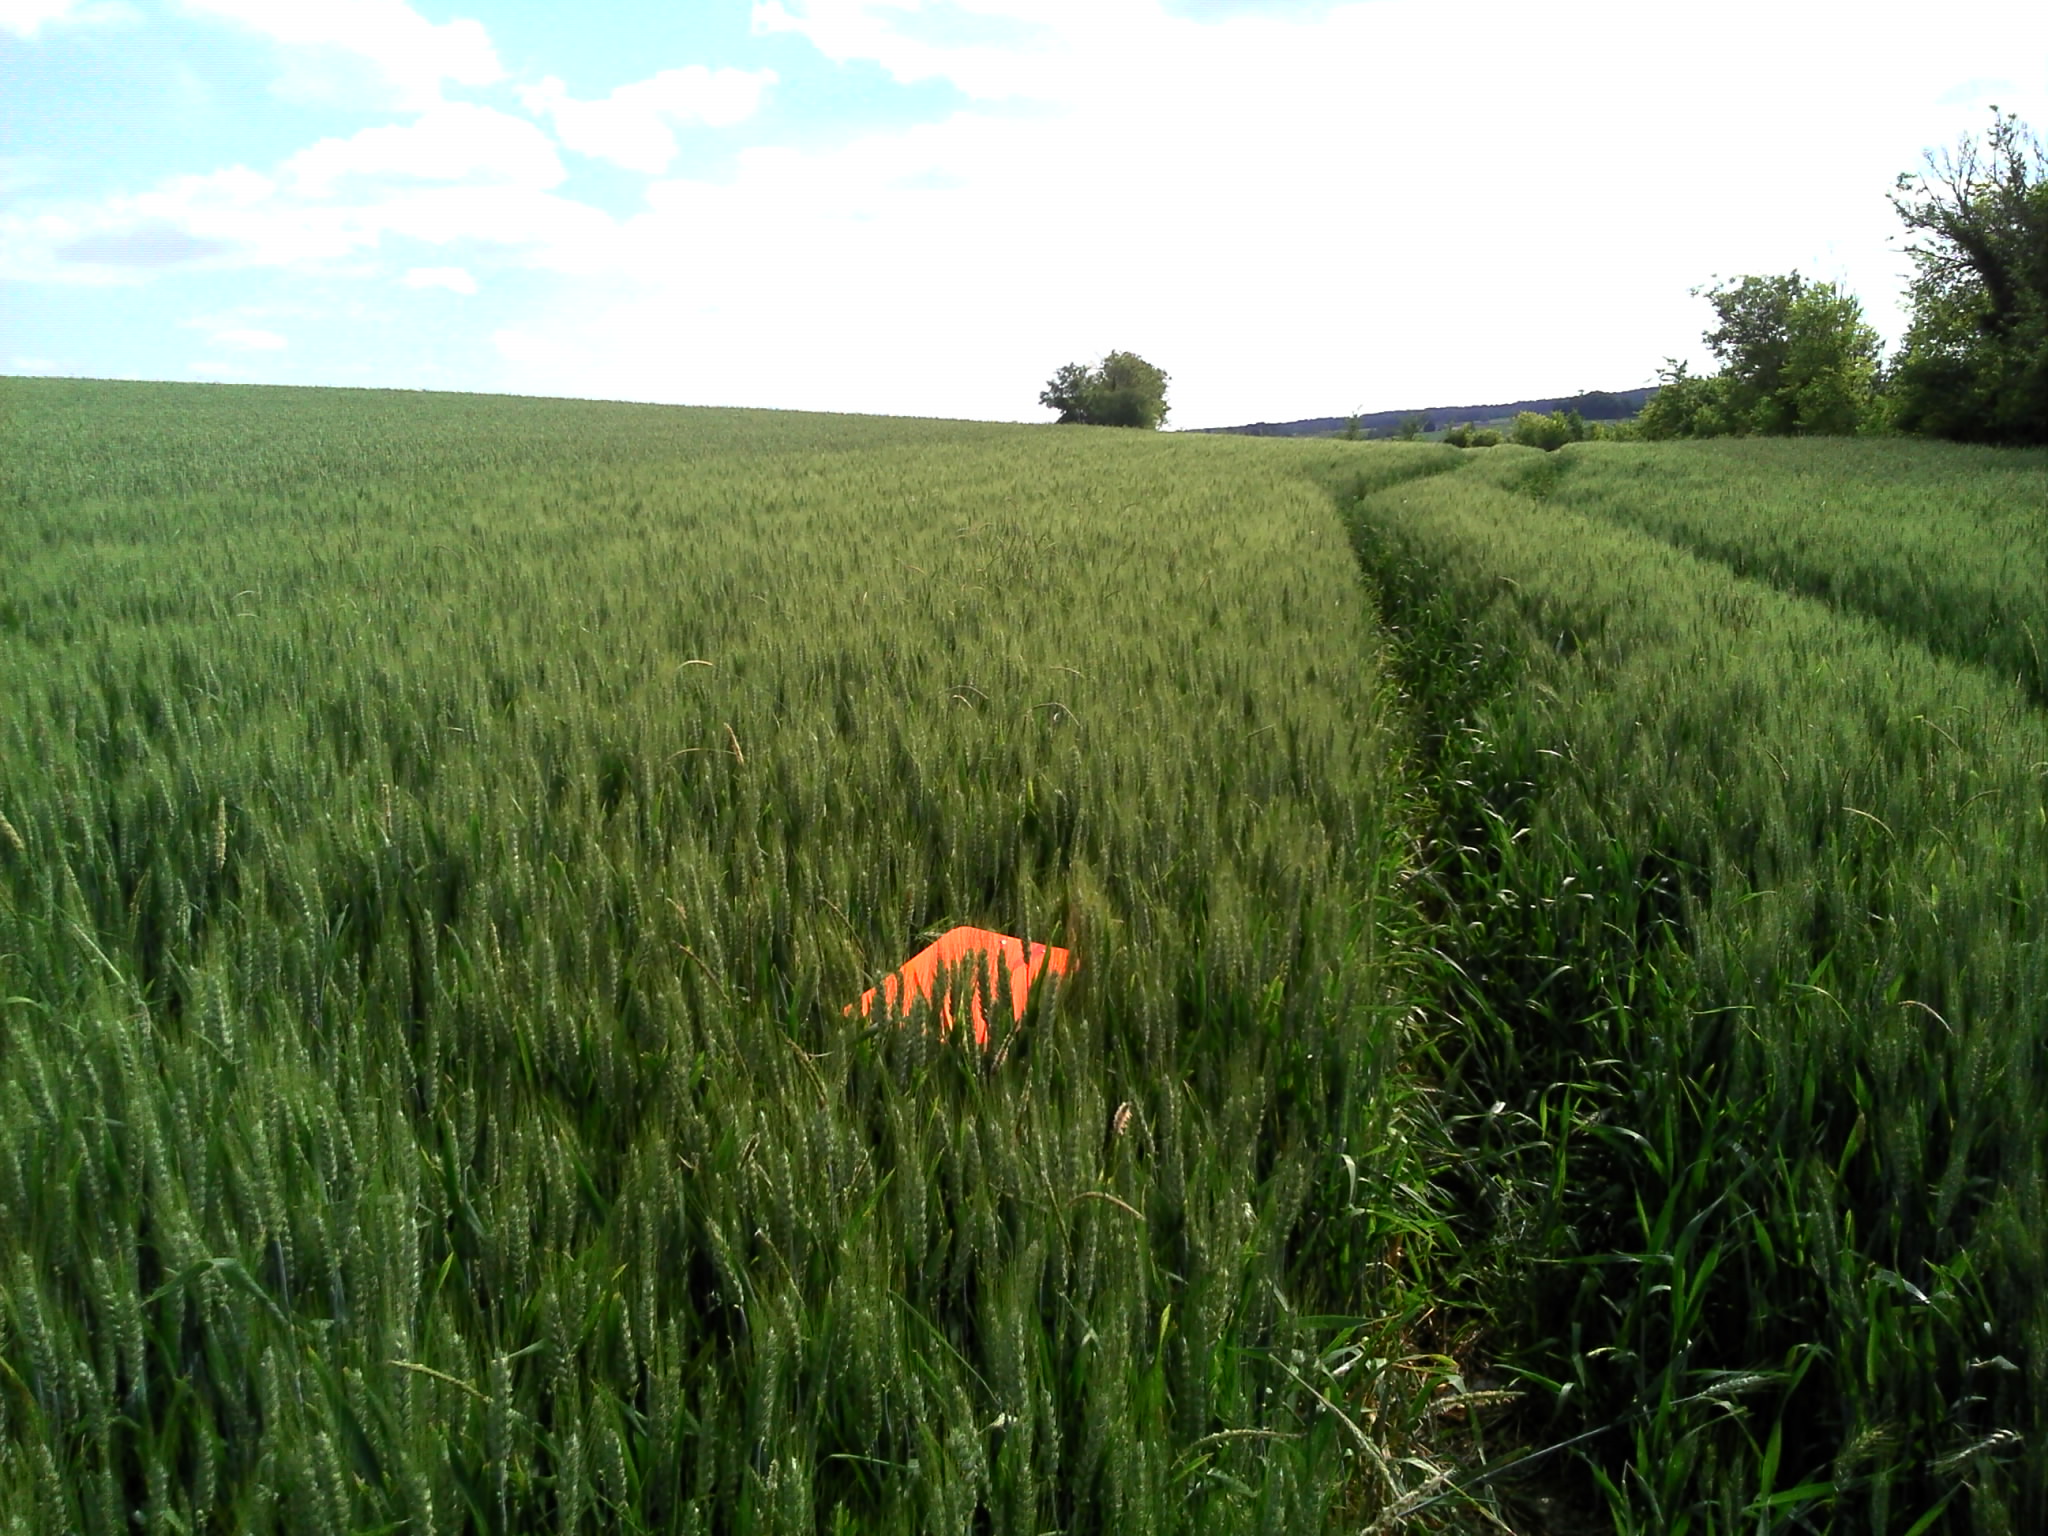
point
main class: Cropland
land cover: Common wheat
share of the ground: > 75 %
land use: Agriculture (excluding fallow land and kitchen gardens)
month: May
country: FR
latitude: 46.9140
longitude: 0.3817
